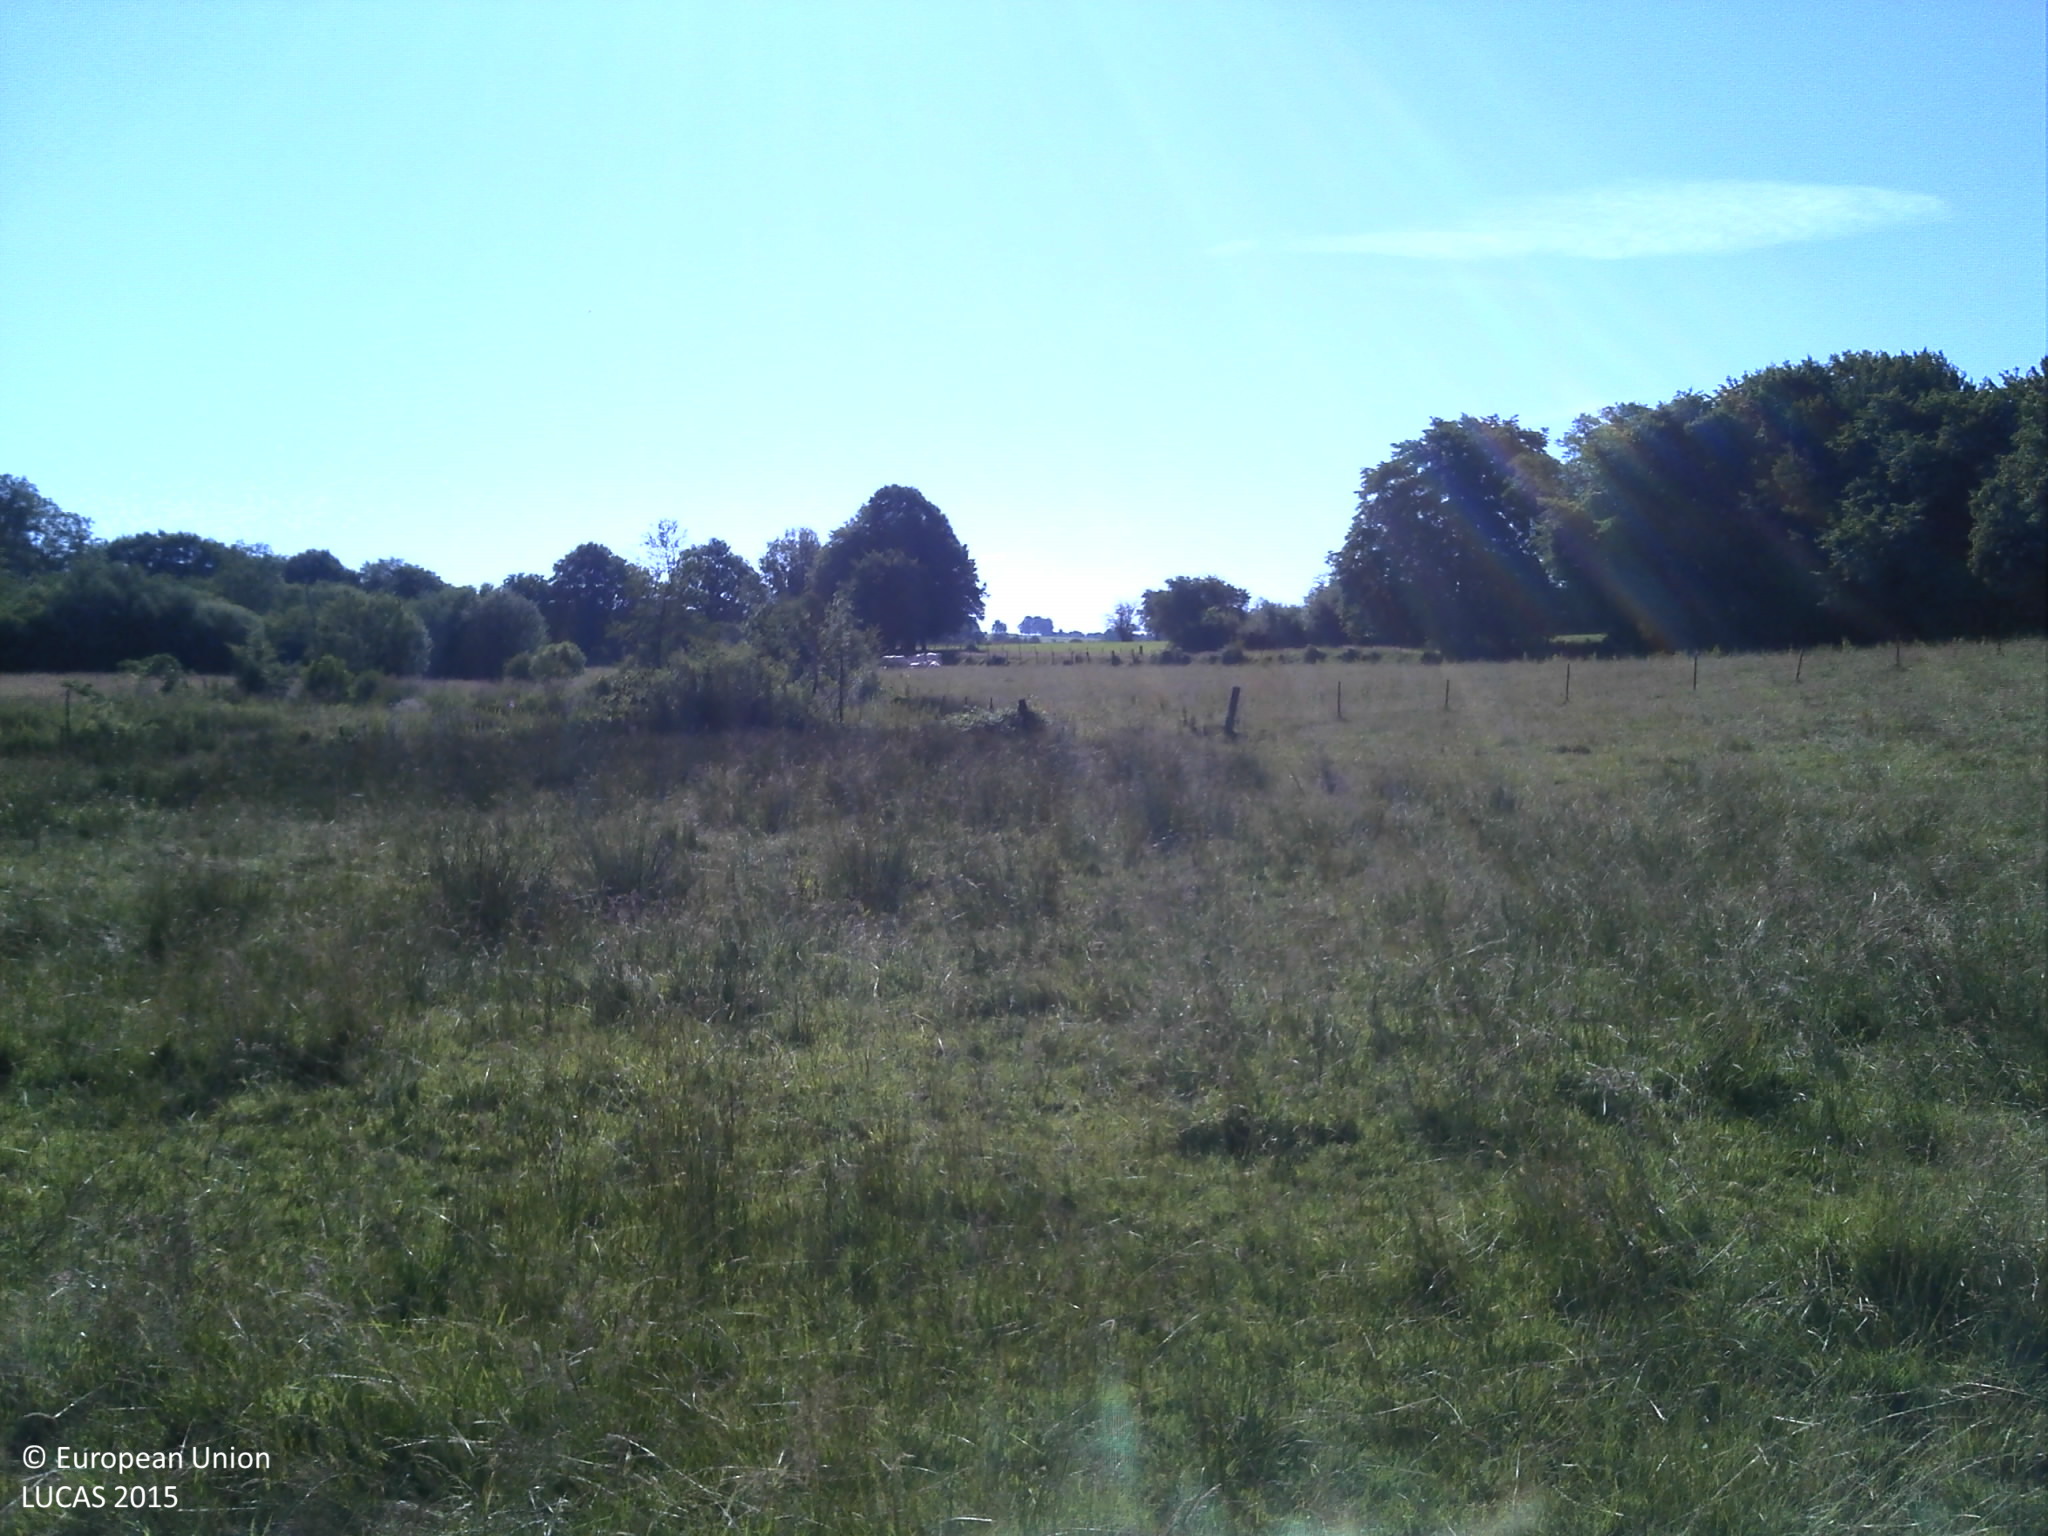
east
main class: Grassland
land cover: Grassland without tree/shrub cover
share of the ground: > 75 %
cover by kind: herbaceous plants 100 %
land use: Agriculture (excluding fallow land and kitchen gardens)
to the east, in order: Grassland without tree/shrub cover; Fences; Shrubland without tree cover; Fences; Grassland without tree/shrub cover
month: July
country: FR
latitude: 49.9403
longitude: 4.4362
